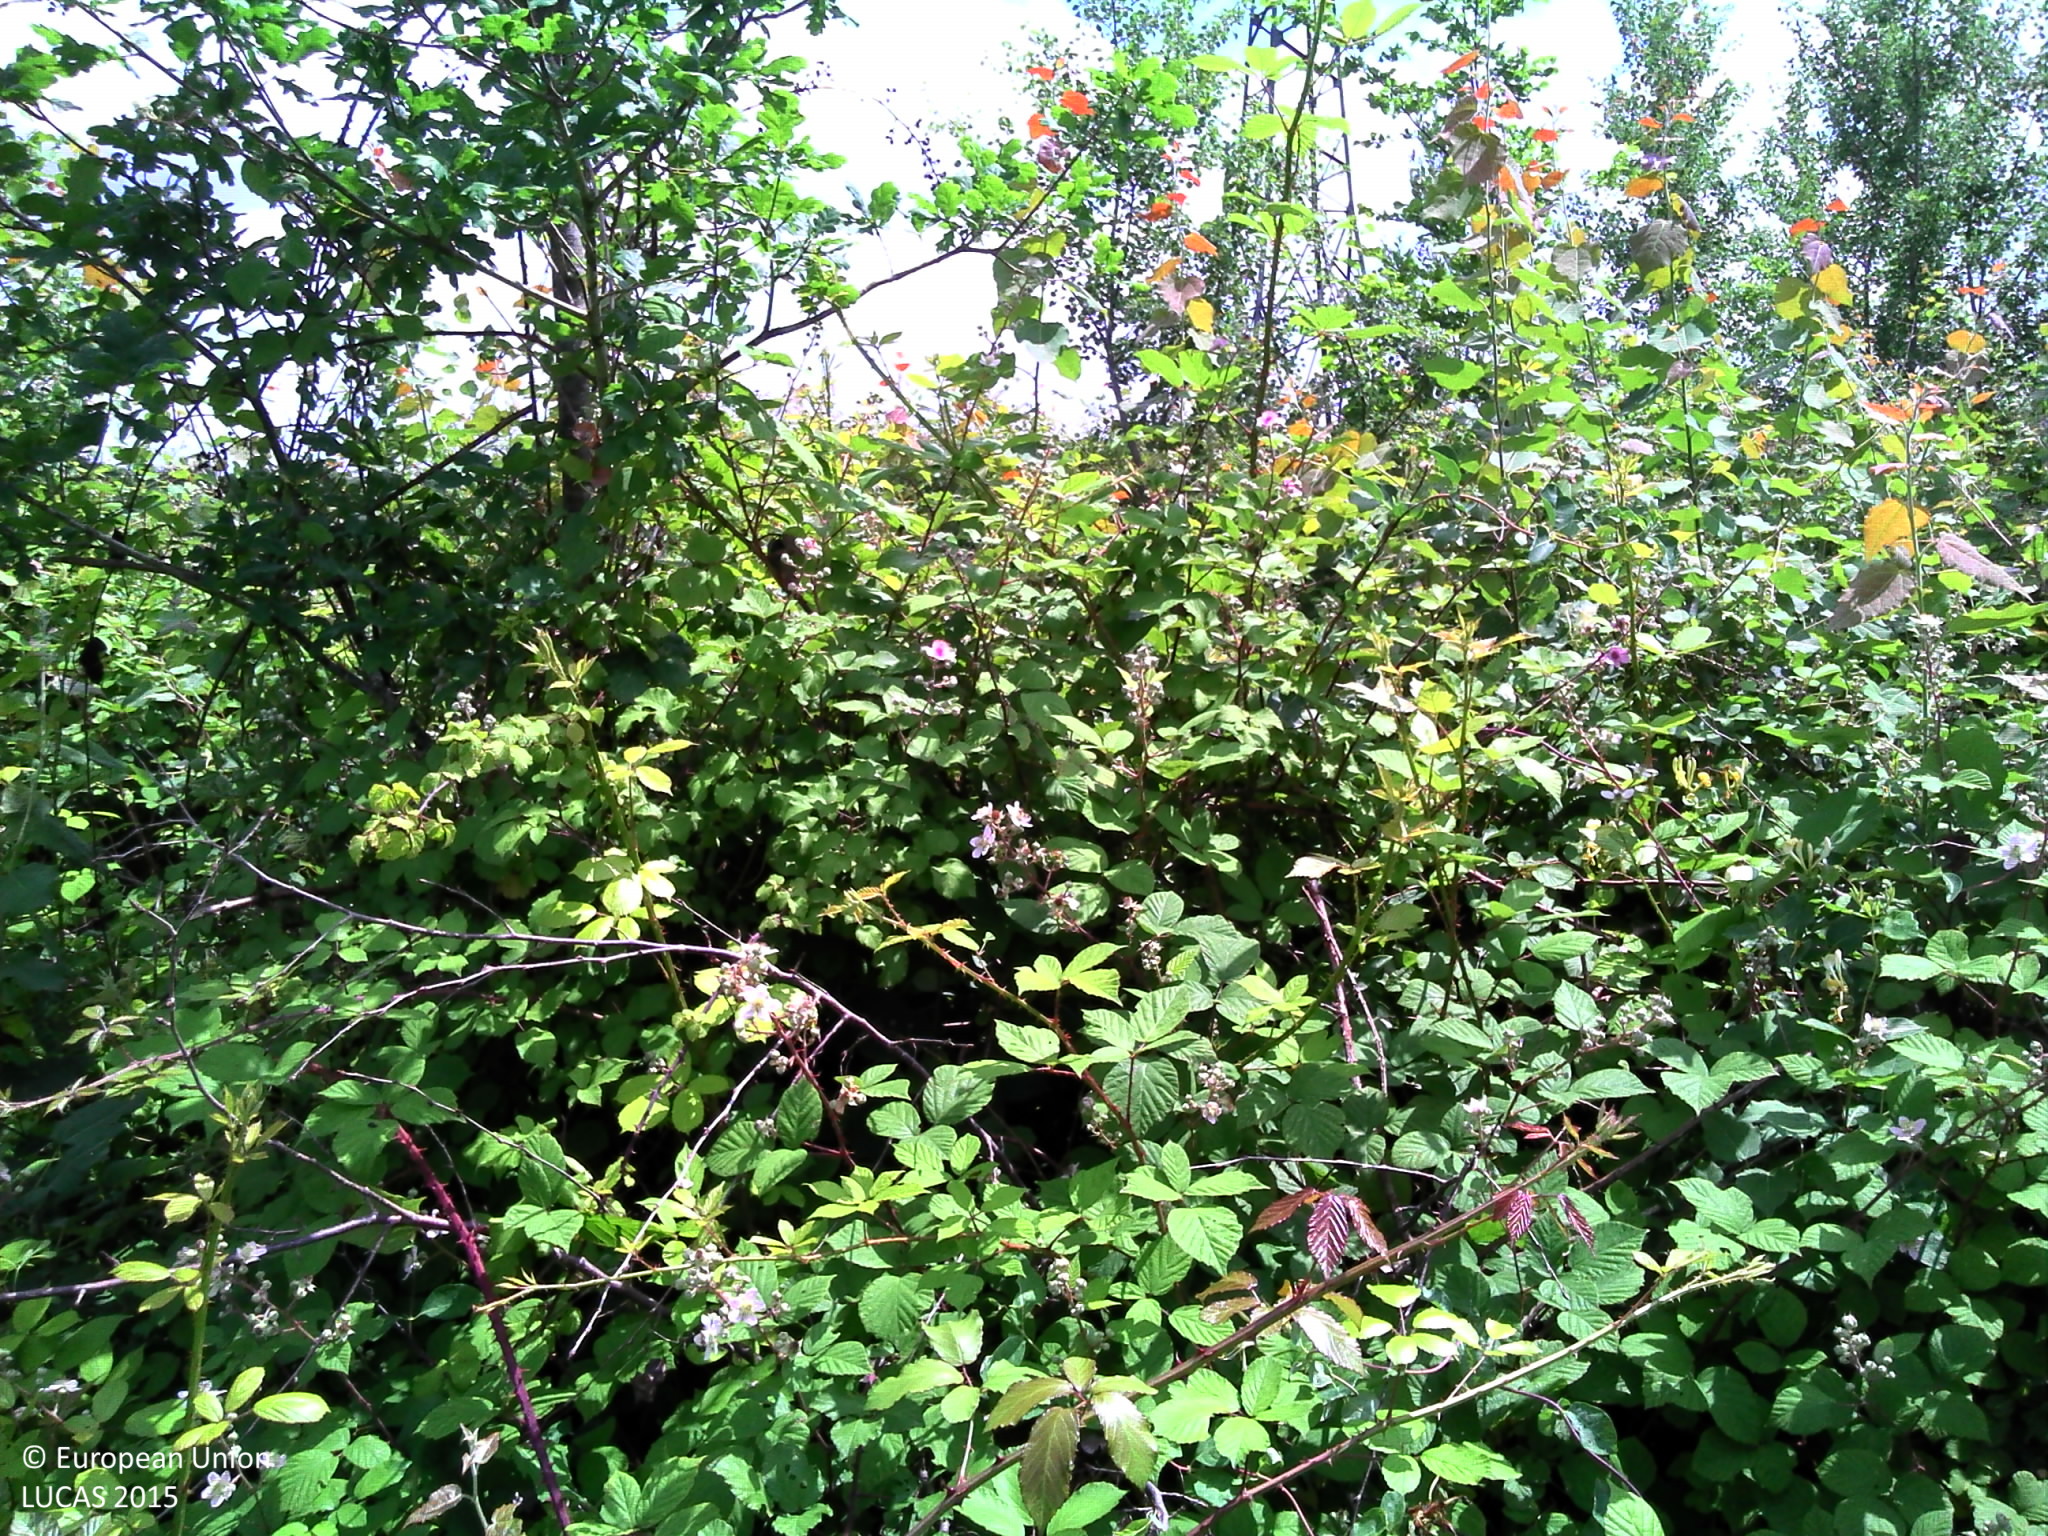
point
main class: Shrubland
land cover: Shrubland without tree cover
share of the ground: > 75 %
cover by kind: shrubs 70 %, herbaceous plants 30 %
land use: Semi-natural and natural areas not in use
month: June
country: FR
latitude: 43.7707
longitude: -0.2331
